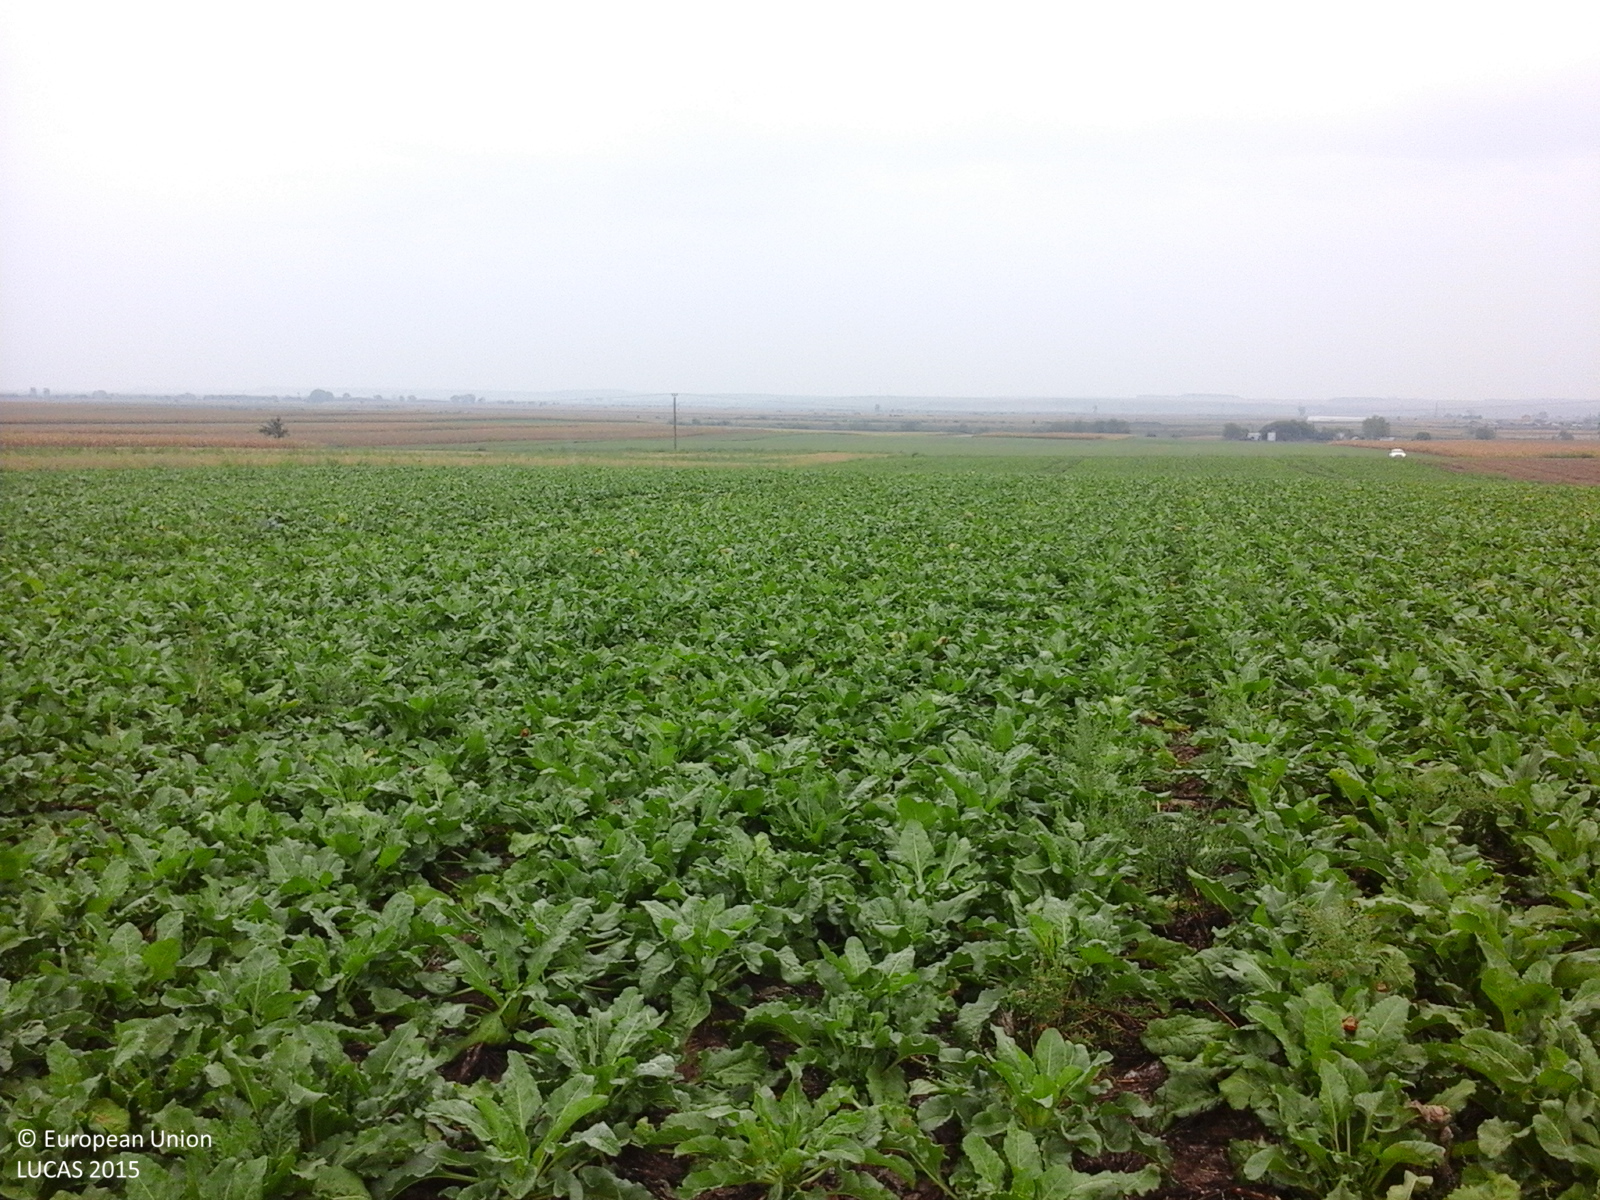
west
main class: Cropland
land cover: Sugar beet
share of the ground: > 75 %
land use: Agriculture (excluding fallow land and kitchen gardens)
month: September
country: RO
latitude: 47.3794
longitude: 22.0362
